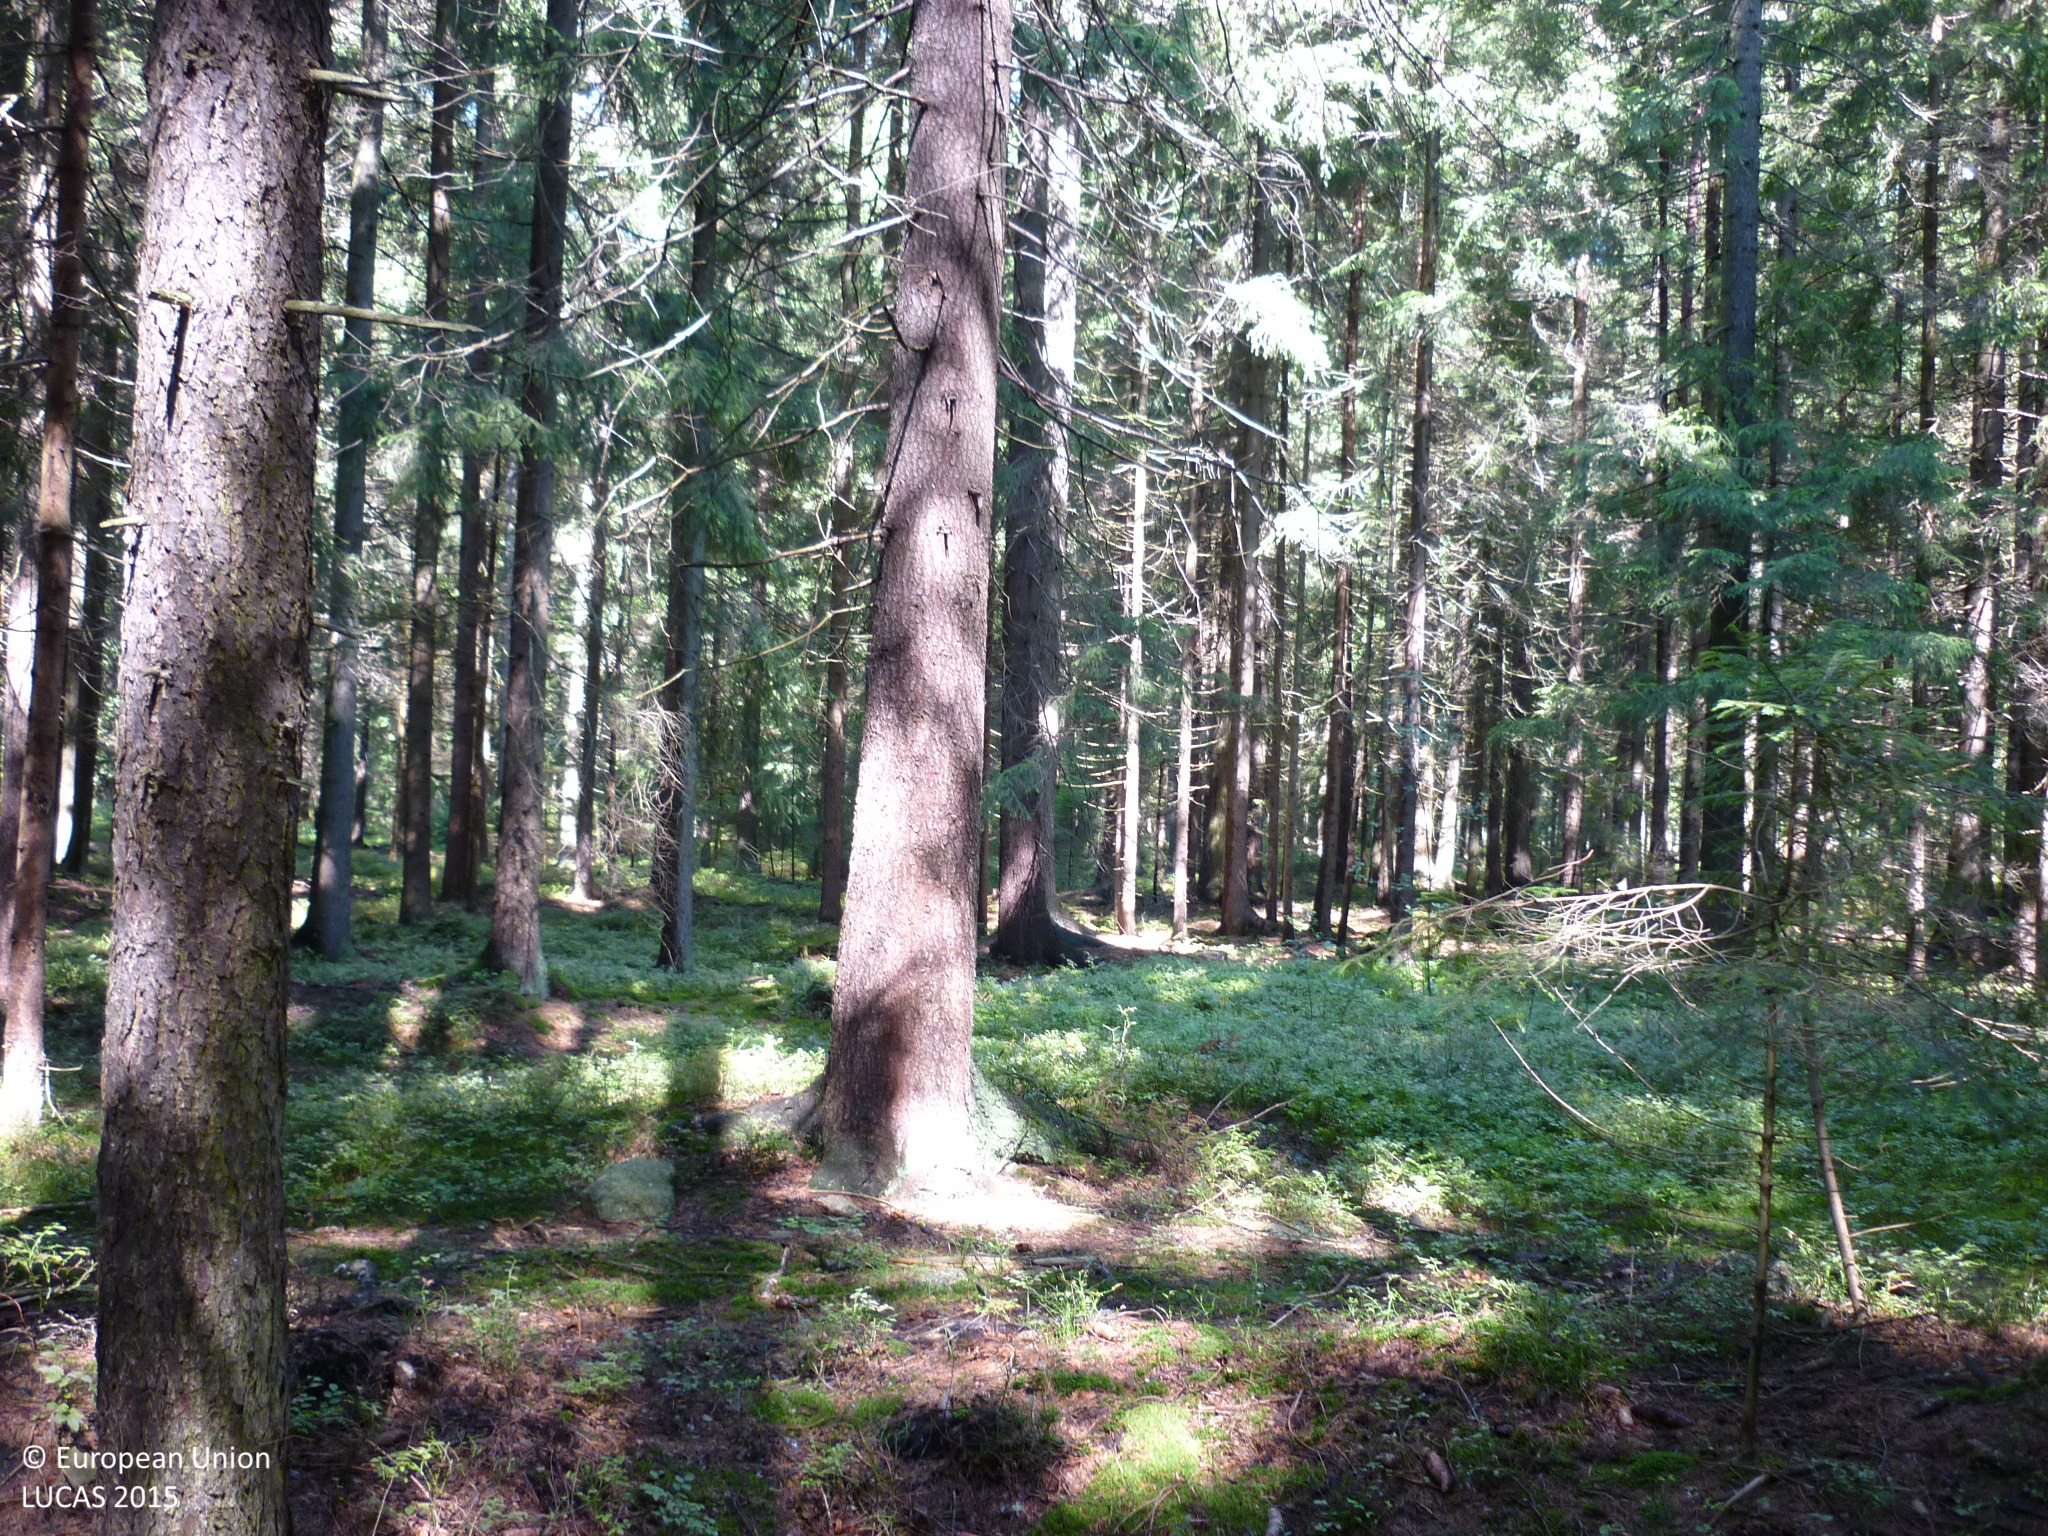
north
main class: Woodland
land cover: Spruce dominated coniferous woodland
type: hemiboreal forest and nemoral coniferous forest and mixed broadleaved-coniferous forest
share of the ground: > 75 %
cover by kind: coniferous forest trees 100 %
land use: Forestry
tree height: > 5 m
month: September
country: AT
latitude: 48.9877
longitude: 15.1269
